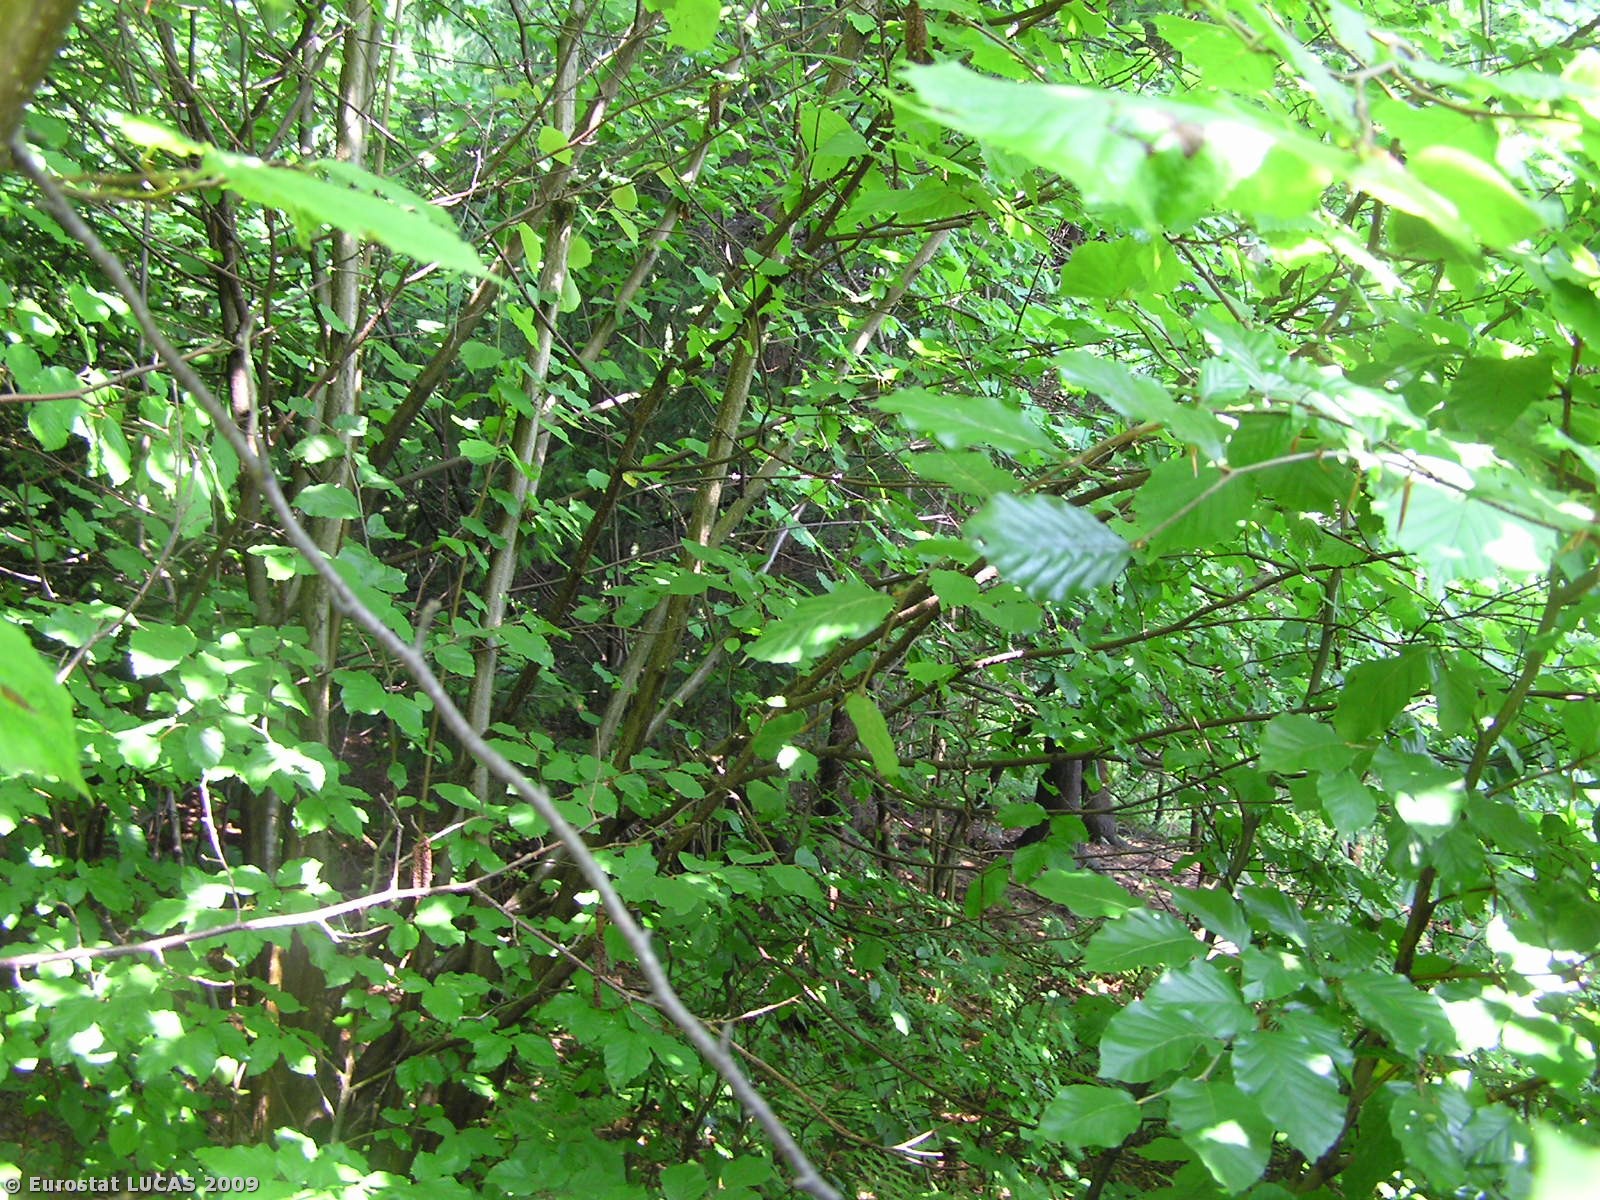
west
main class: Woodland
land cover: Mixed woodland
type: hemiboreal forest and nemoral coniferous forest and mixed broadleaved-coniferous forest
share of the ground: > 75 %
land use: Forestry
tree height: > 5 m
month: June
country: CZ
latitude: 50.2647
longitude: 17.4615
